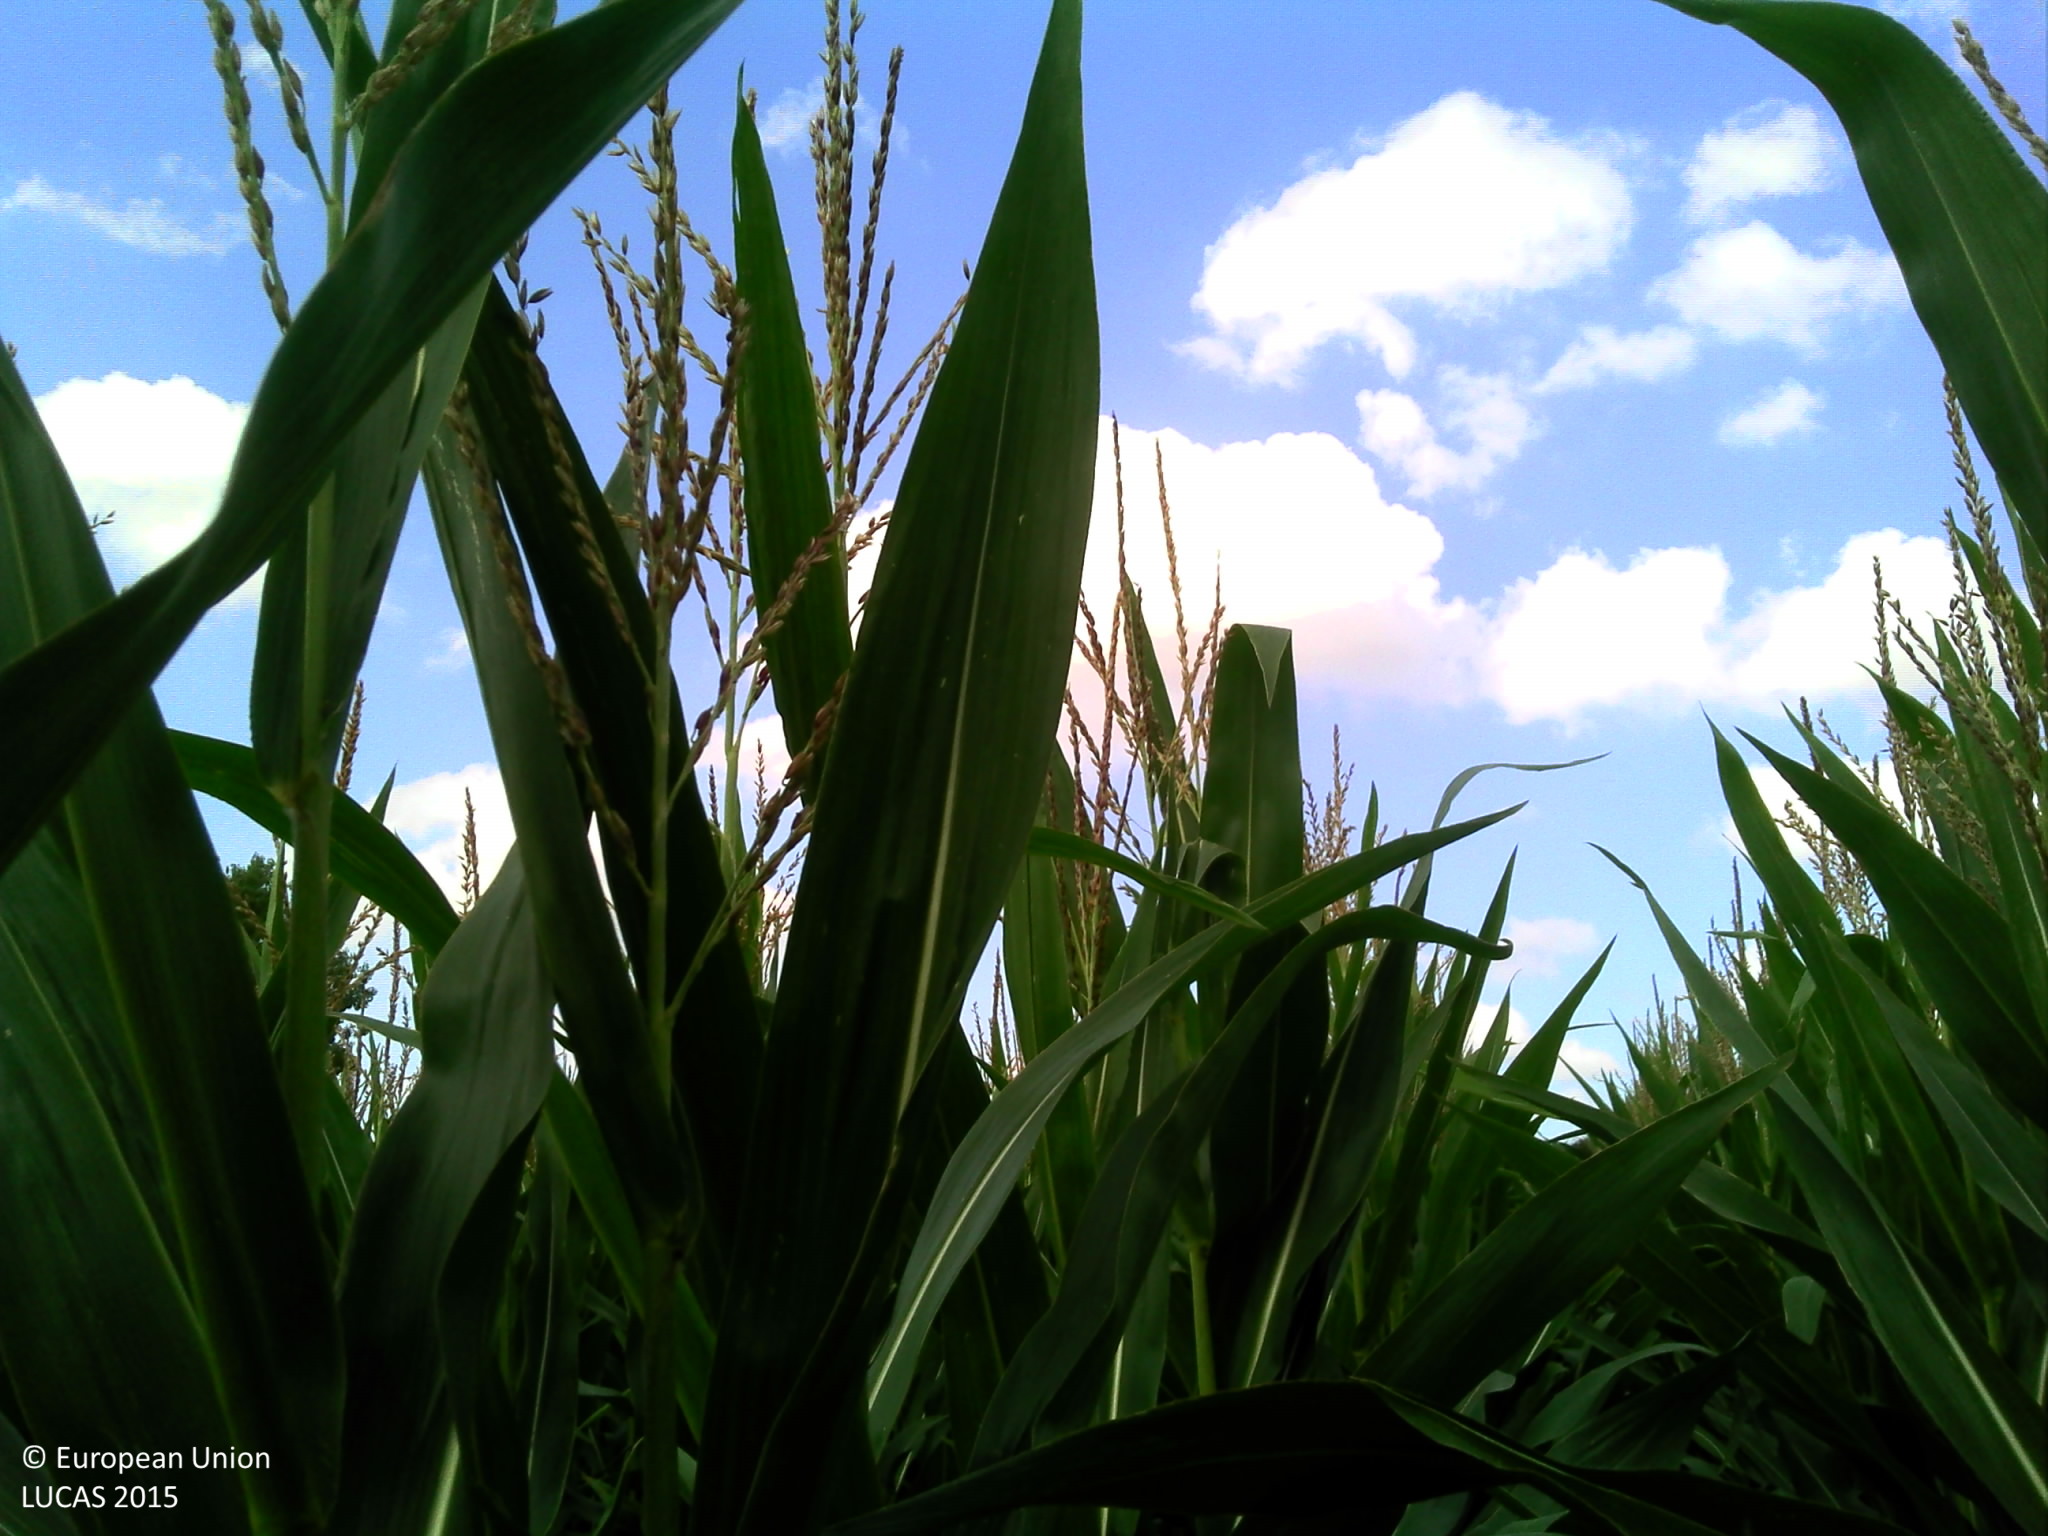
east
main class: Cropland
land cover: Maize
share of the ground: > 75 %
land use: Agriculture (excluding fallow land and kitchen gardens)
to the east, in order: Maize
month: August
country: FR
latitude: 48.3304
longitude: -2.1552
